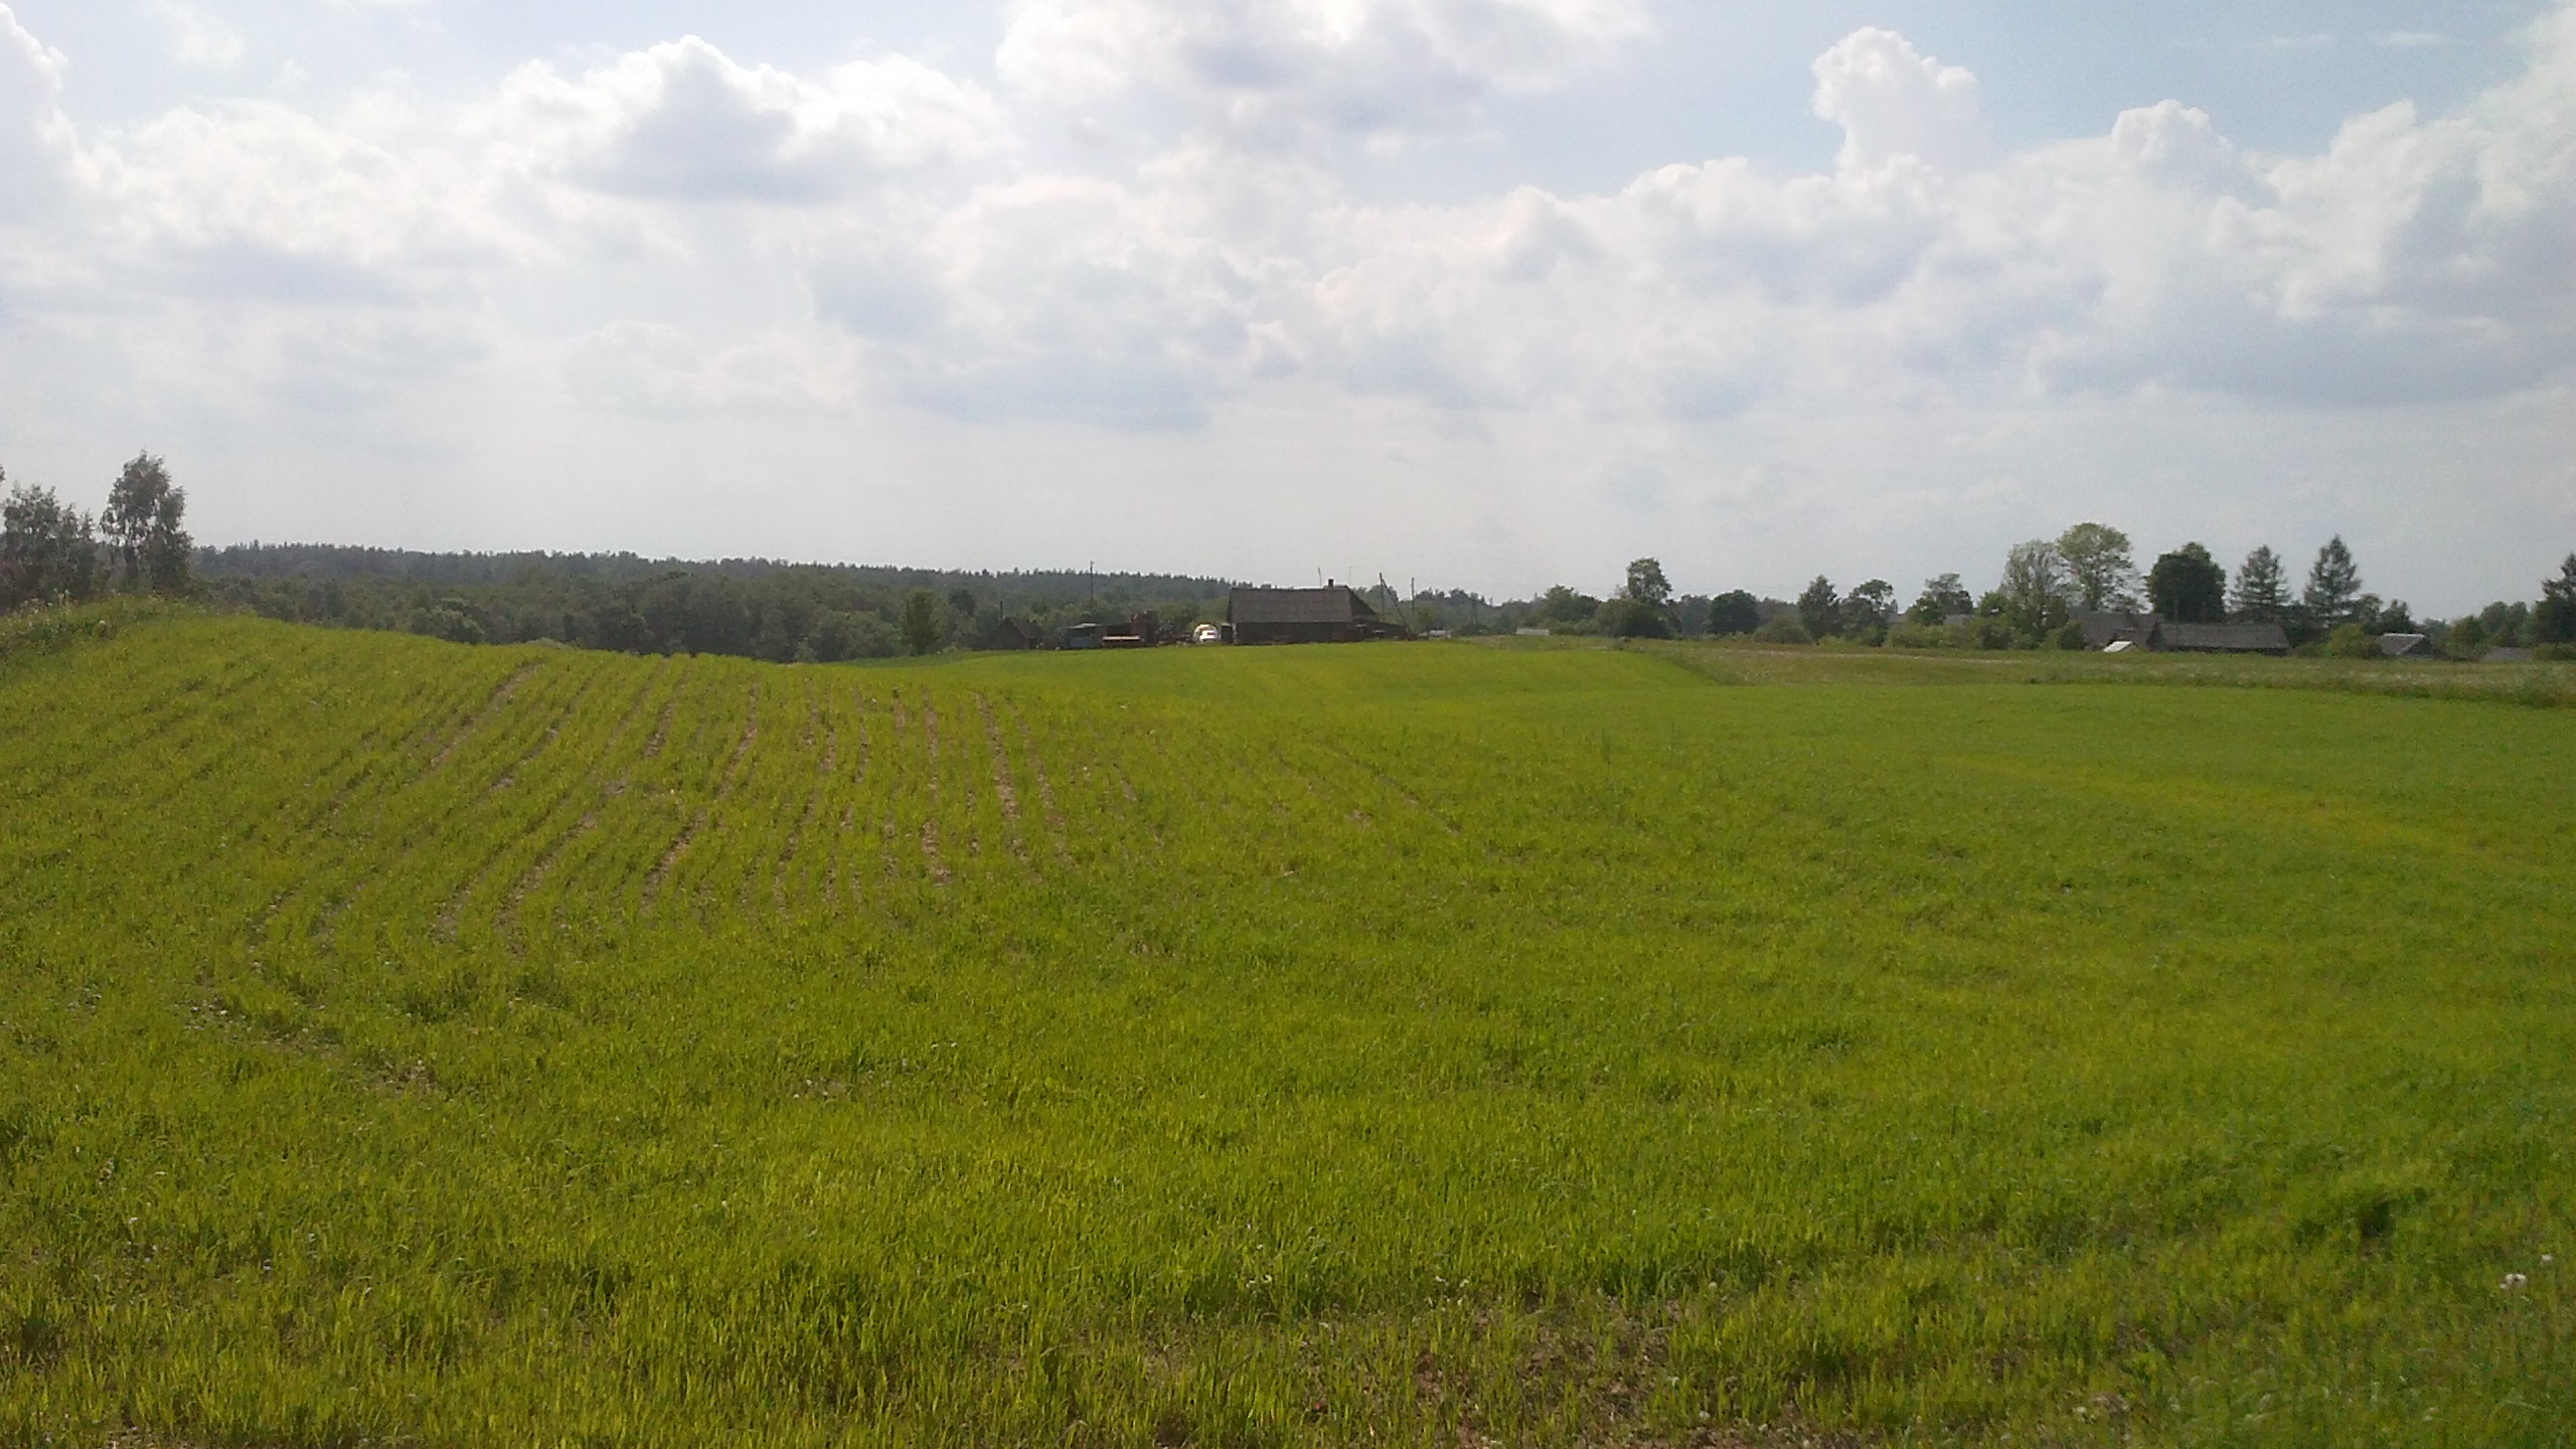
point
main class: Cropland
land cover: Oats
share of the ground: > 75 %
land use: Agriculture (excluding fallow land and kitchen gardens)
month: June
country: LV
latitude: 56.2127
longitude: 28.1151
